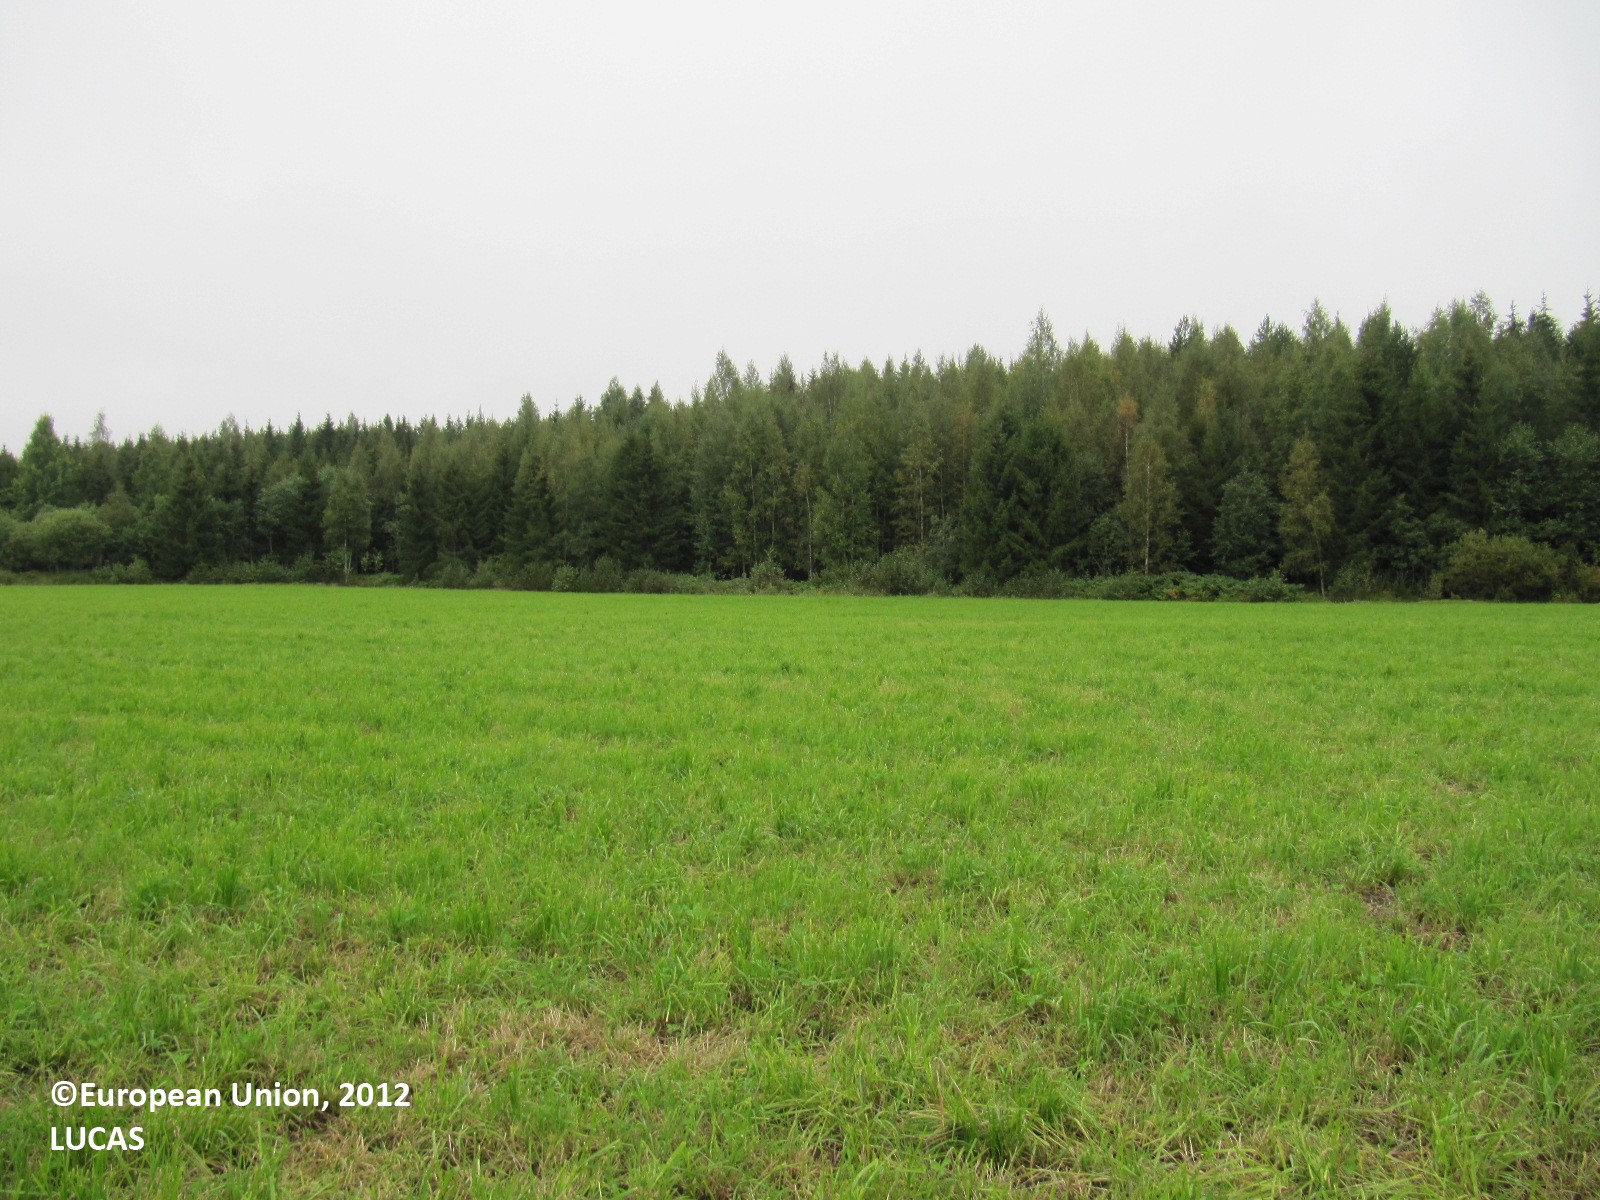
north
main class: Grassland
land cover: Grassland without tree/shrub cover
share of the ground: > 75 %
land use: Agriculture (excluding fallow land and kitchen gardens)
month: August
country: FI
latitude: 61.1030
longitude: 23.4946
